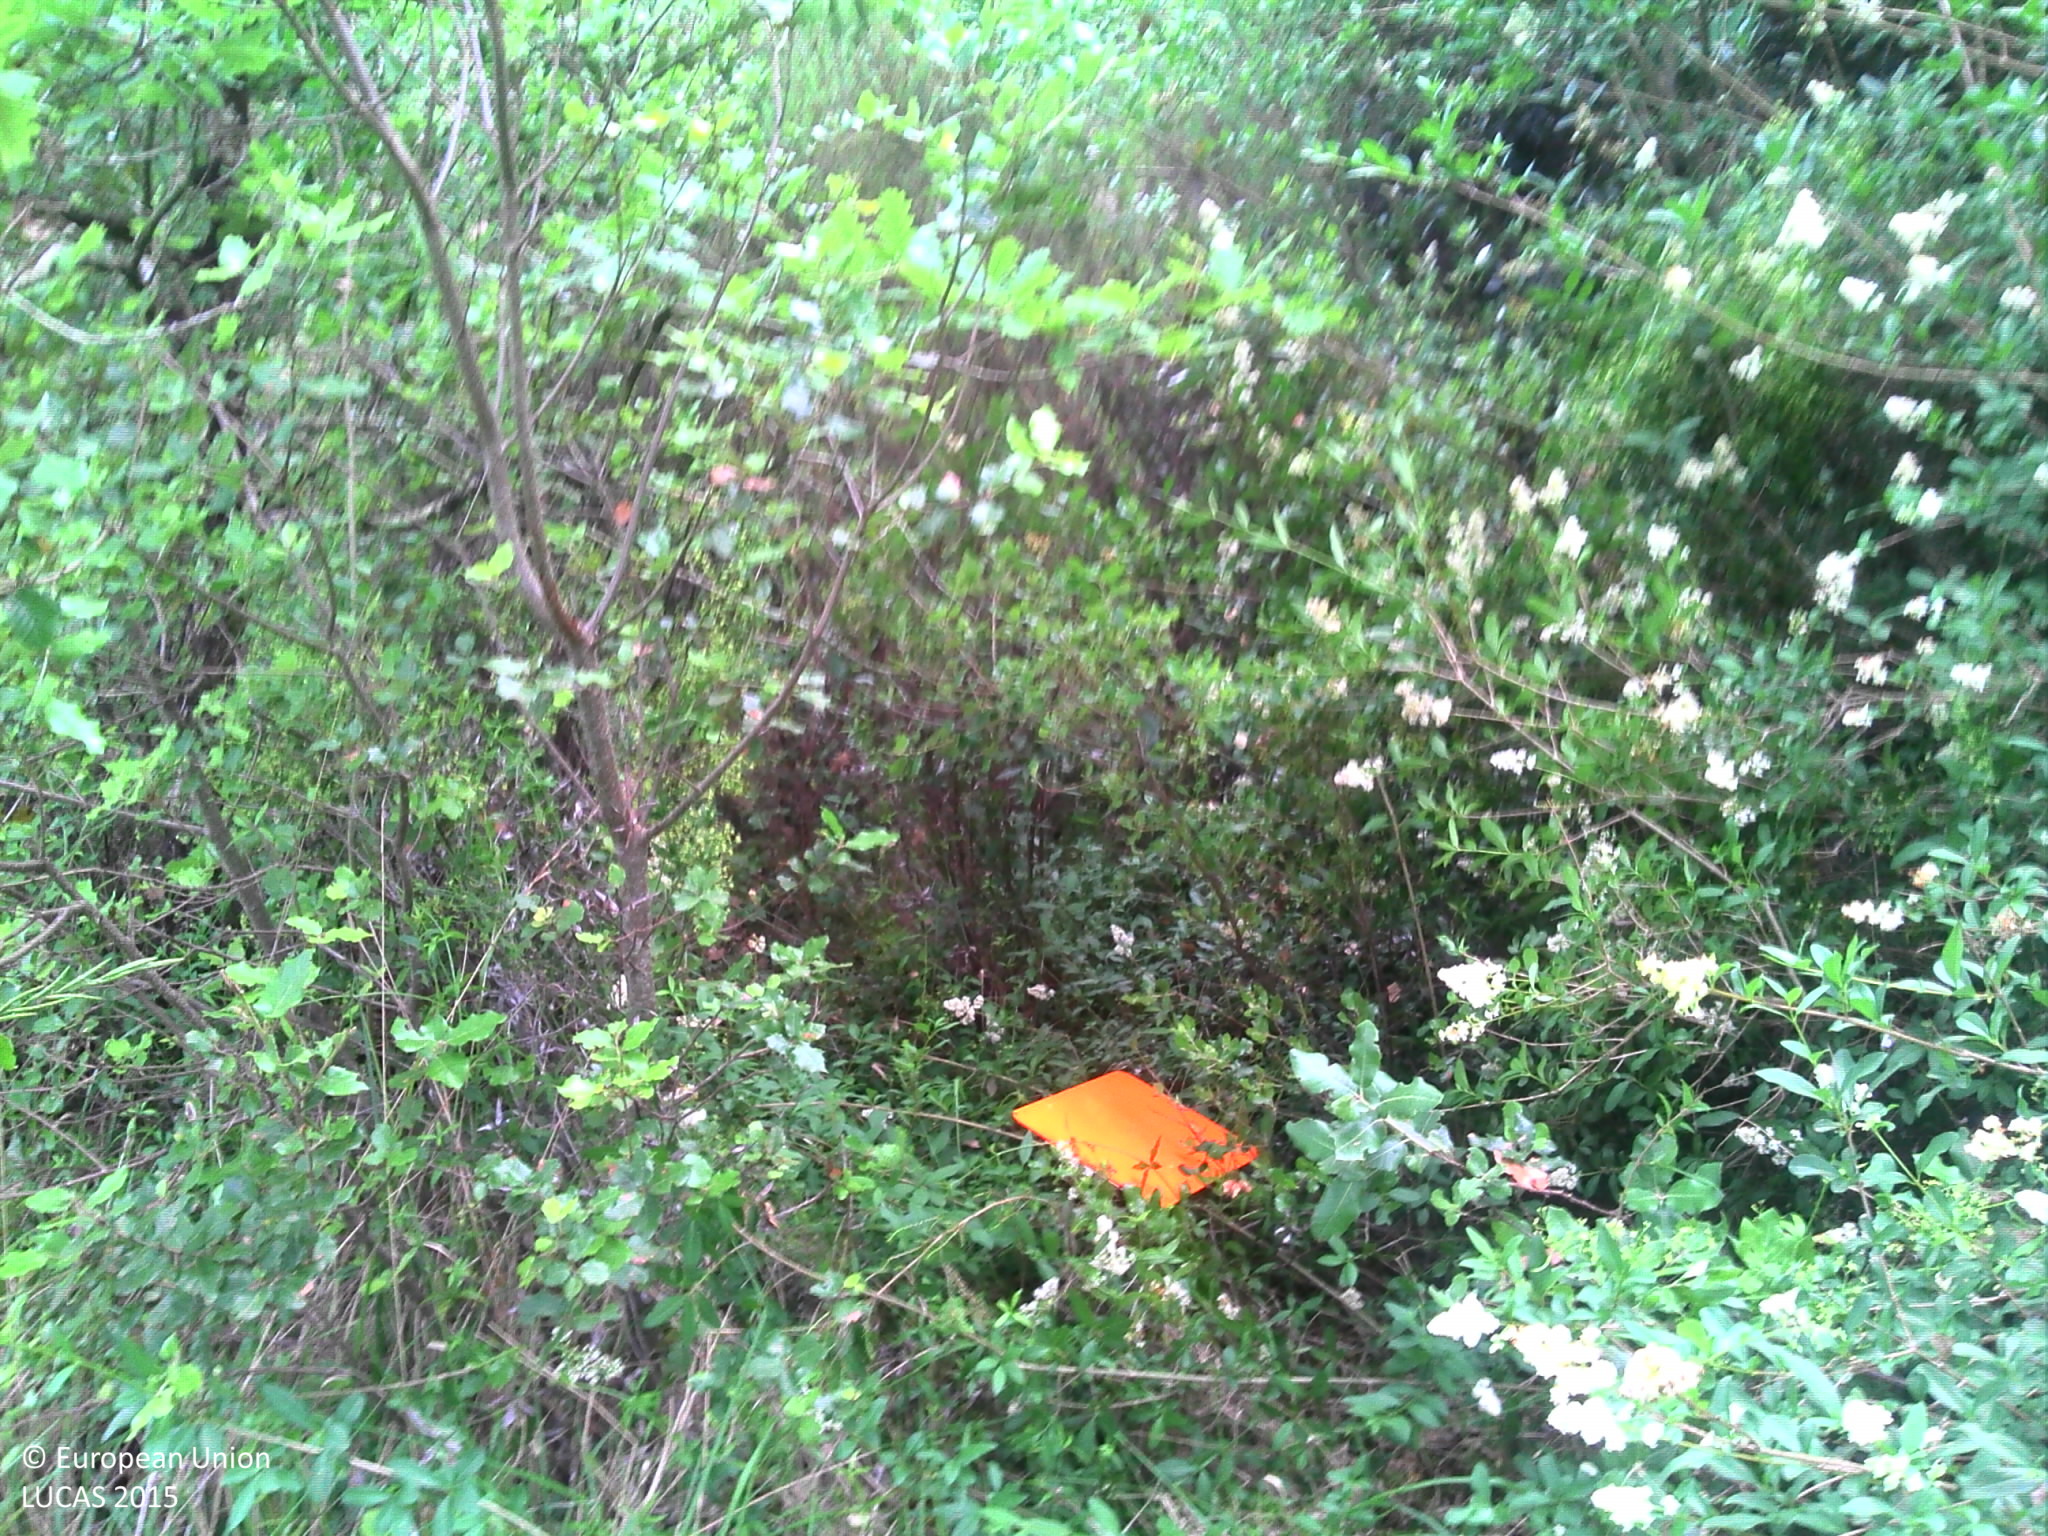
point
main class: Woodland
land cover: Broadleaved woodland
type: beech forest
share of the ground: 25 - 50 %
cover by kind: broadleaved forest trees 100 %
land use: Forestry
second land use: Amenities, museums, leisure
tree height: > 5 m
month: June
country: FR
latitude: 45.9000
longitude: -0.7370
